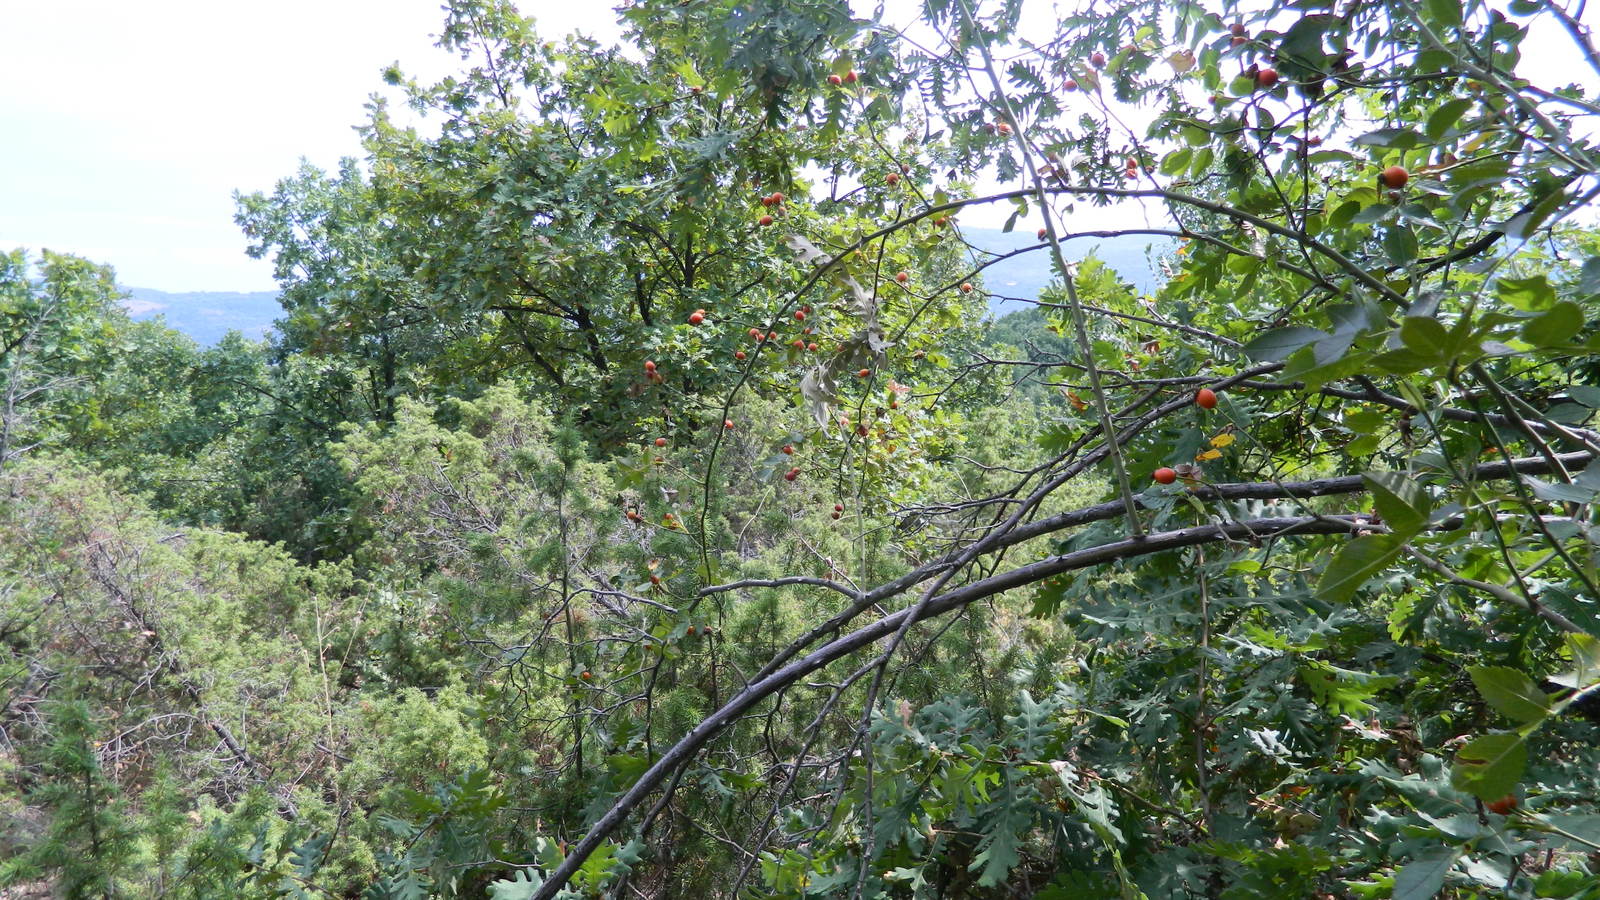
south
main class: Woodland
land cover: Broadleaved woodland
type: mesophytic deciduous forest
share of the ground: > 75 %
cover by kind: broadleaved forest trees 80 %, unconsolidated bare surface 15 %, shrubs 5 %
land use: Forestry
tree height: > 5 m
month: August
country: BG
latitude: 41.6956
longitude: 25.8192
